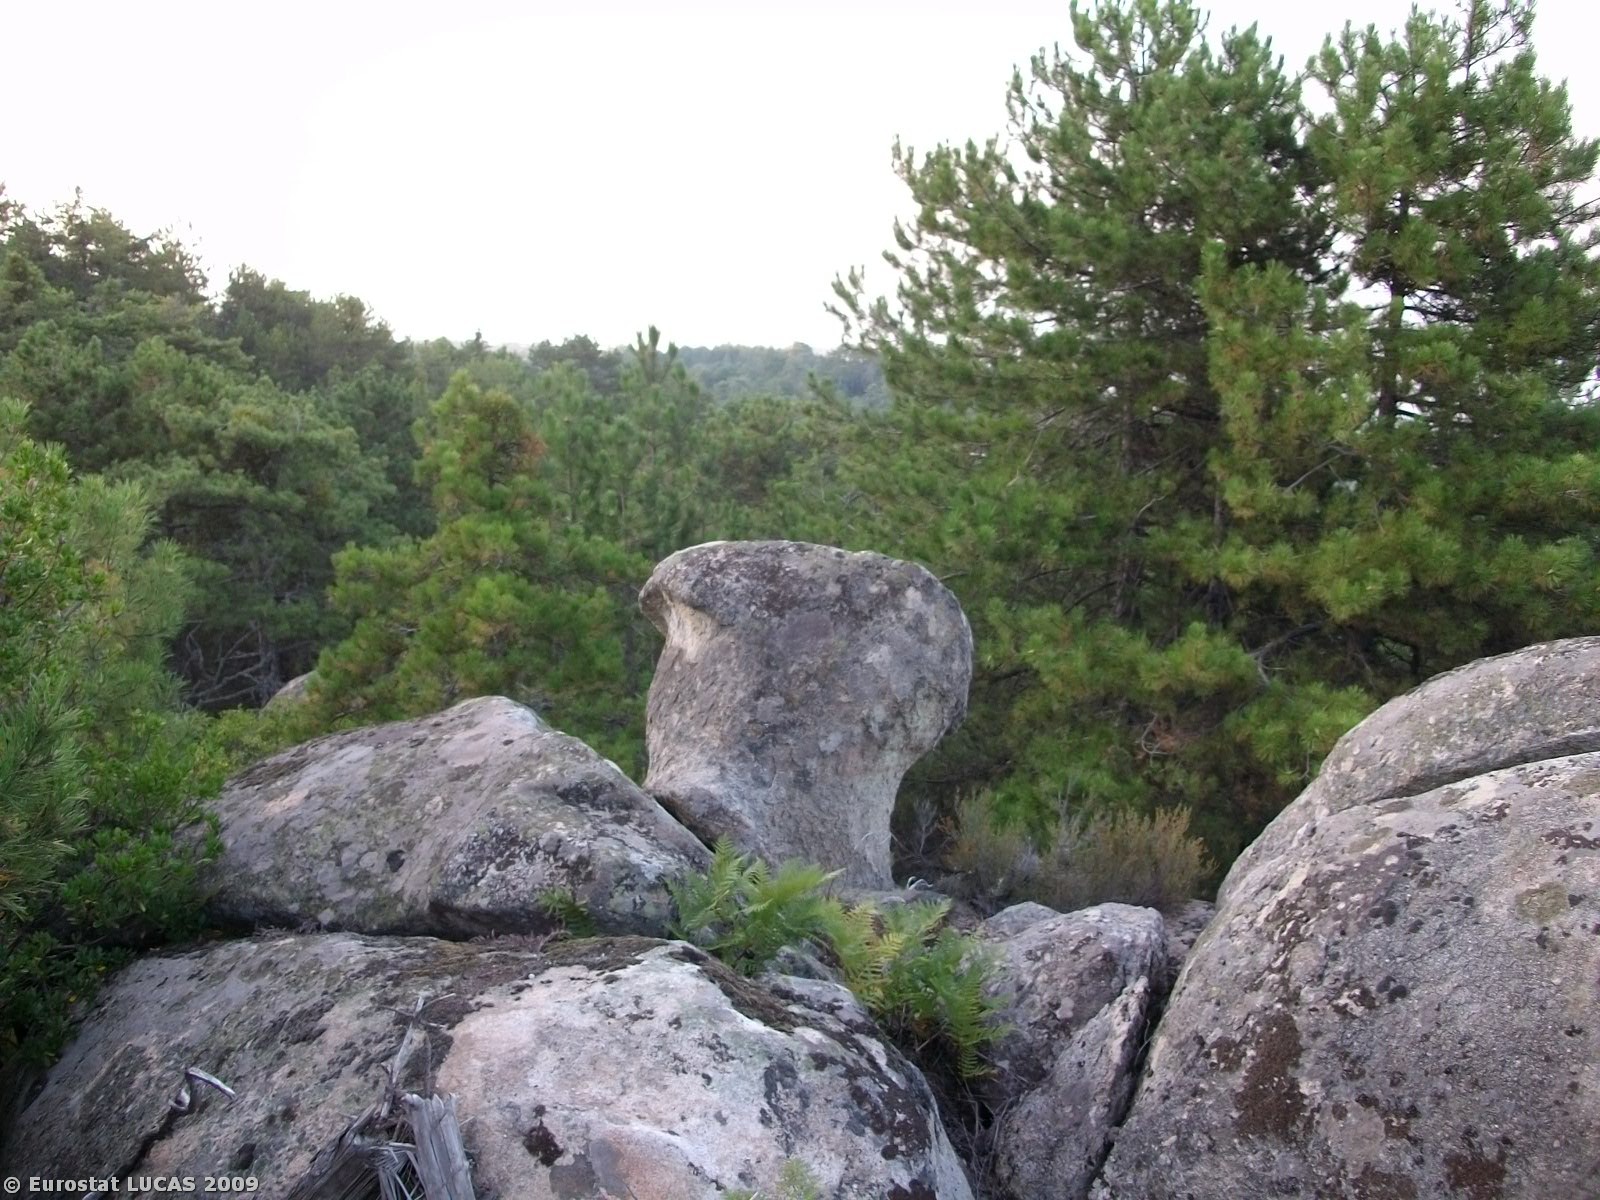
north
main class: Woodland
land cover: Coniferous woodland
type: coniferous forest of the mediterranean region
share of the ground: 50 - 75 %
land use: Forestry
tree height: > 5 m
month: August
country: GR
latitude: 40.1166
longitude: 23.8931
